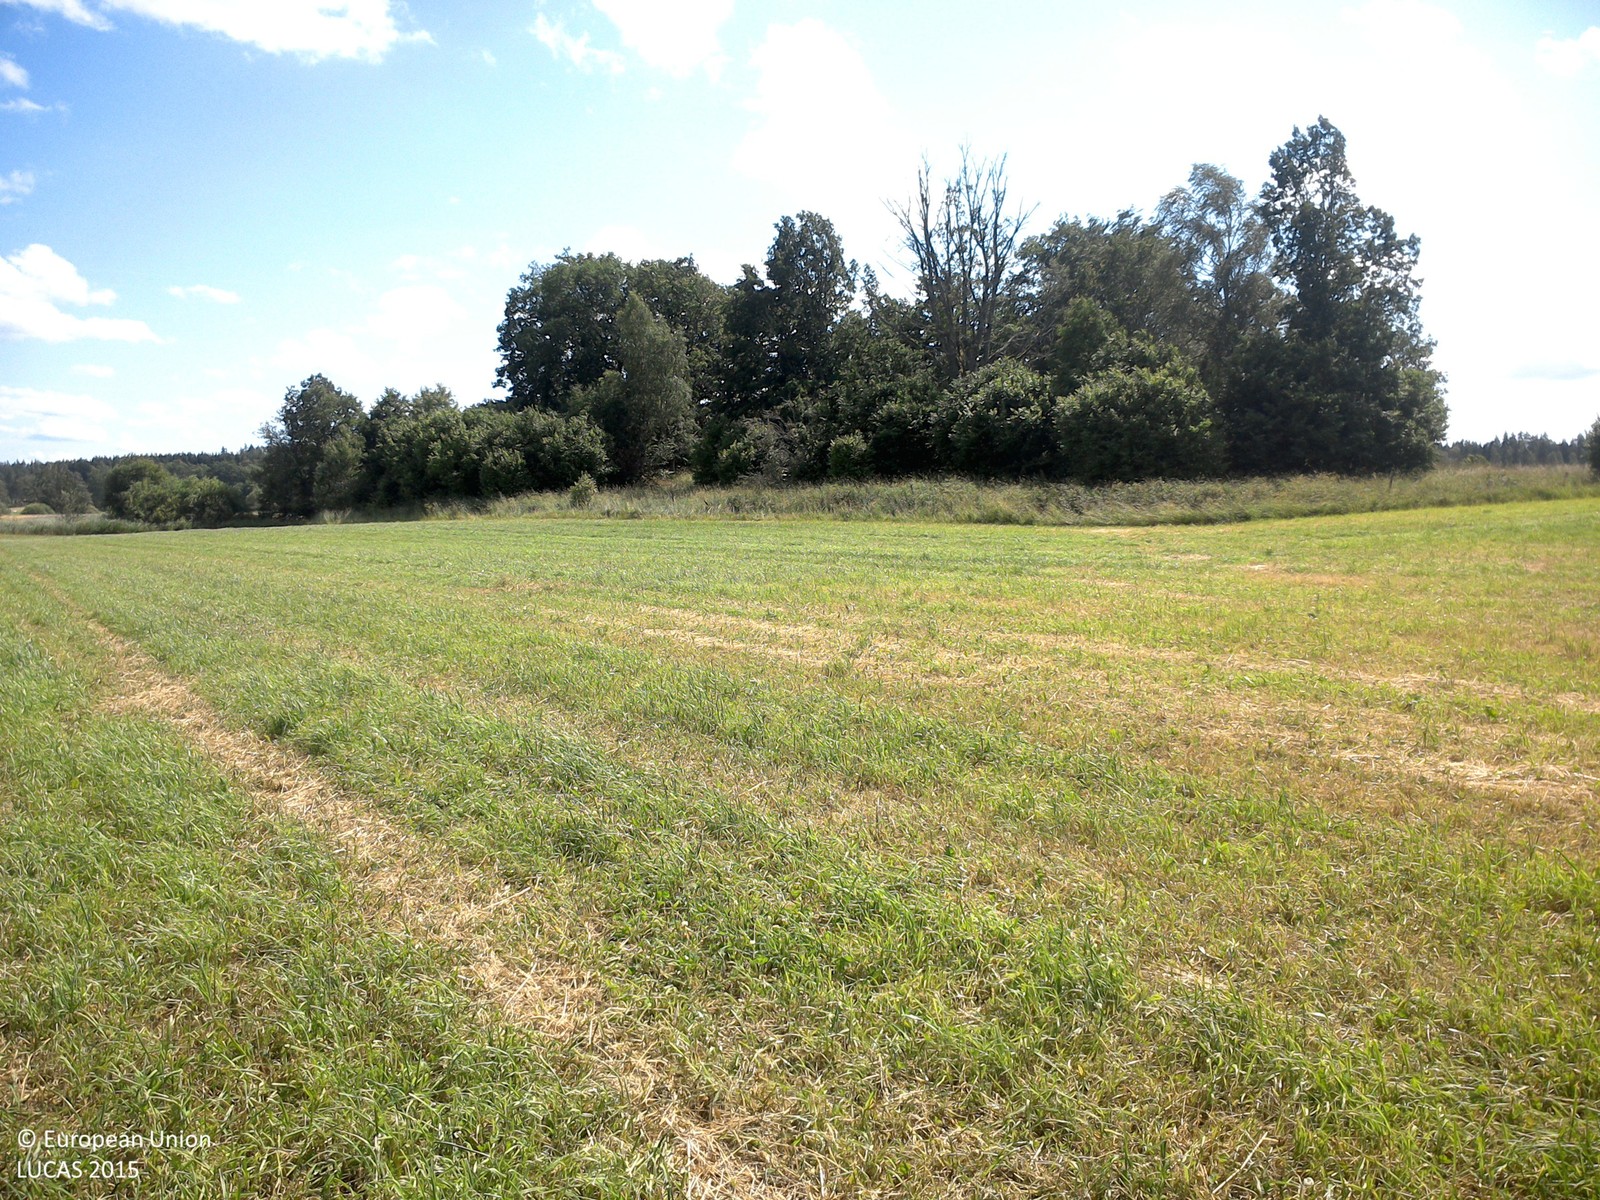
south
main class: Cropland
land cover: Other leguminous and mixtures for fodder
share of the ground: > 75 %
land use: Agriculture (excluding fallow land and kitchen gardens)
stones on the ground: < 10 %
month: July
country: SE
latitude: 58.2953
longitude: 15.3002
